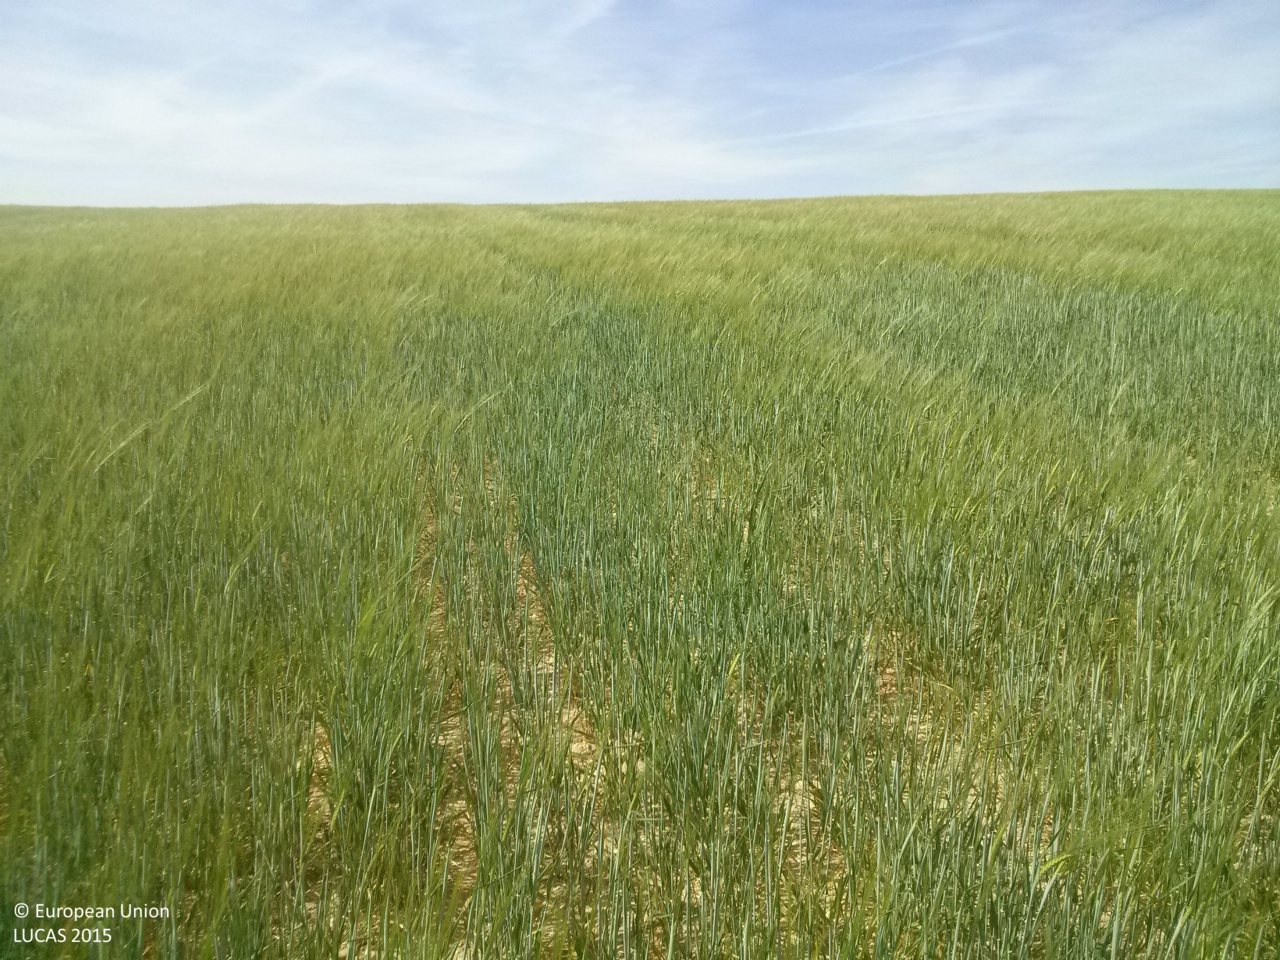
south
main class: Cropland
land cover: Barley
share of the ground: > 75 %
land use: Agriculture (excluding fallow land and kitchen gardens)
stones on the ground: 25 - 50 %
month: May
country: ES
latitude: 39.7758
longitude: -2.6378
